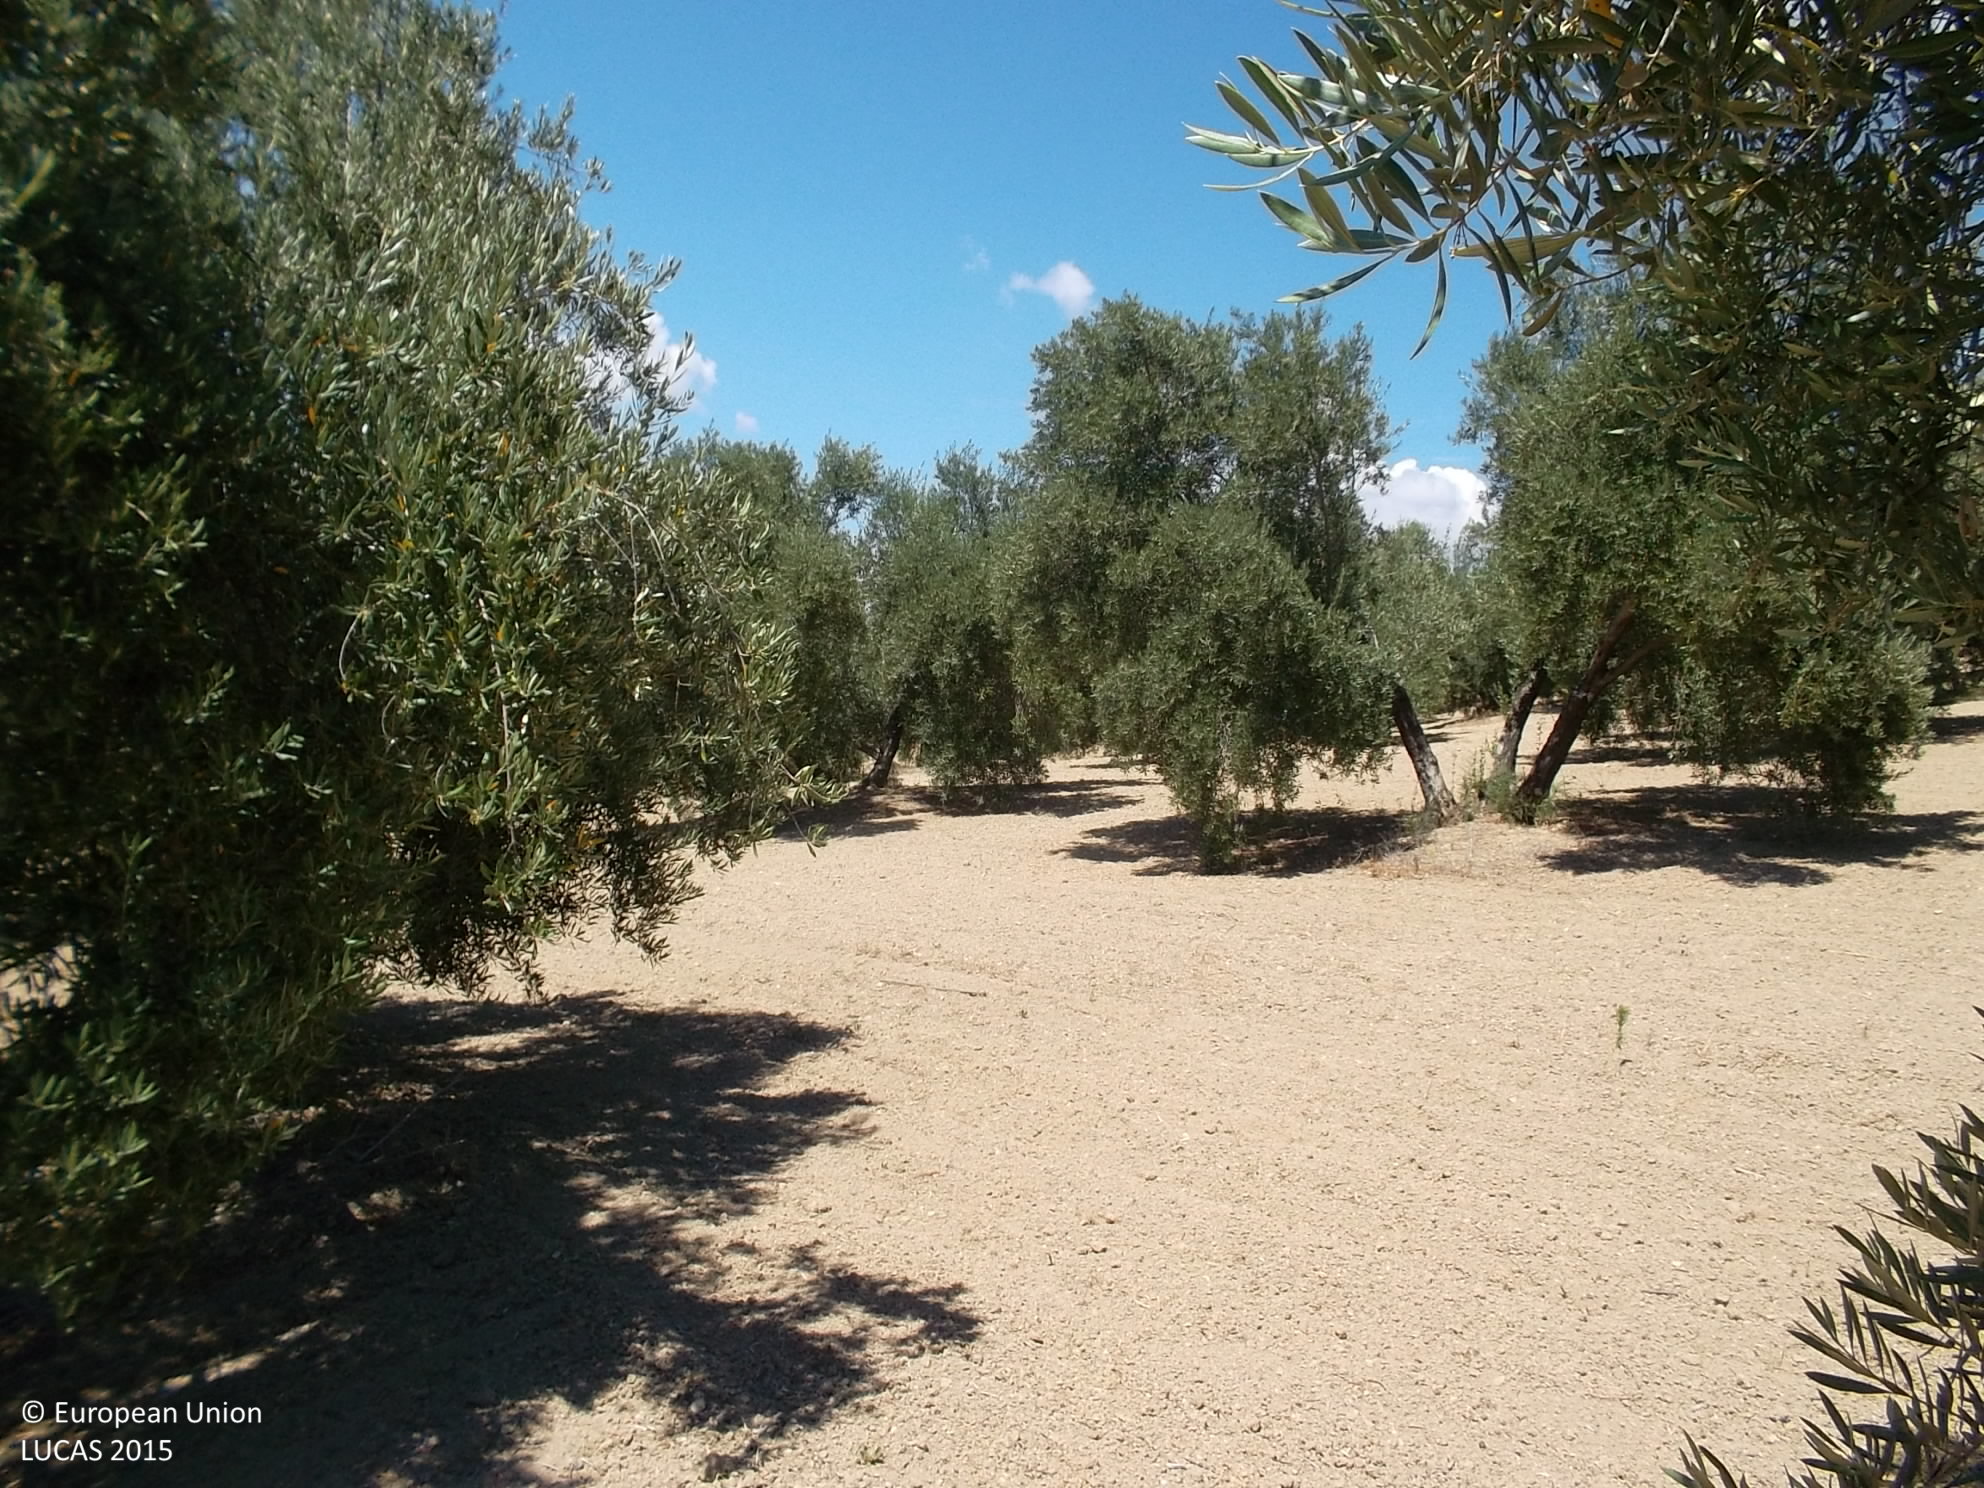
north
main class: Cropland
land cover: Olive groves
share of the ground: 25 - 50 %
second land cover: Other bare soil
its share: > 75 %
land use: Agriculture (excluding fallow land and kitchen gardens)
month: June
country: ES
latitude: 38.0340
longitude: -3.0655
